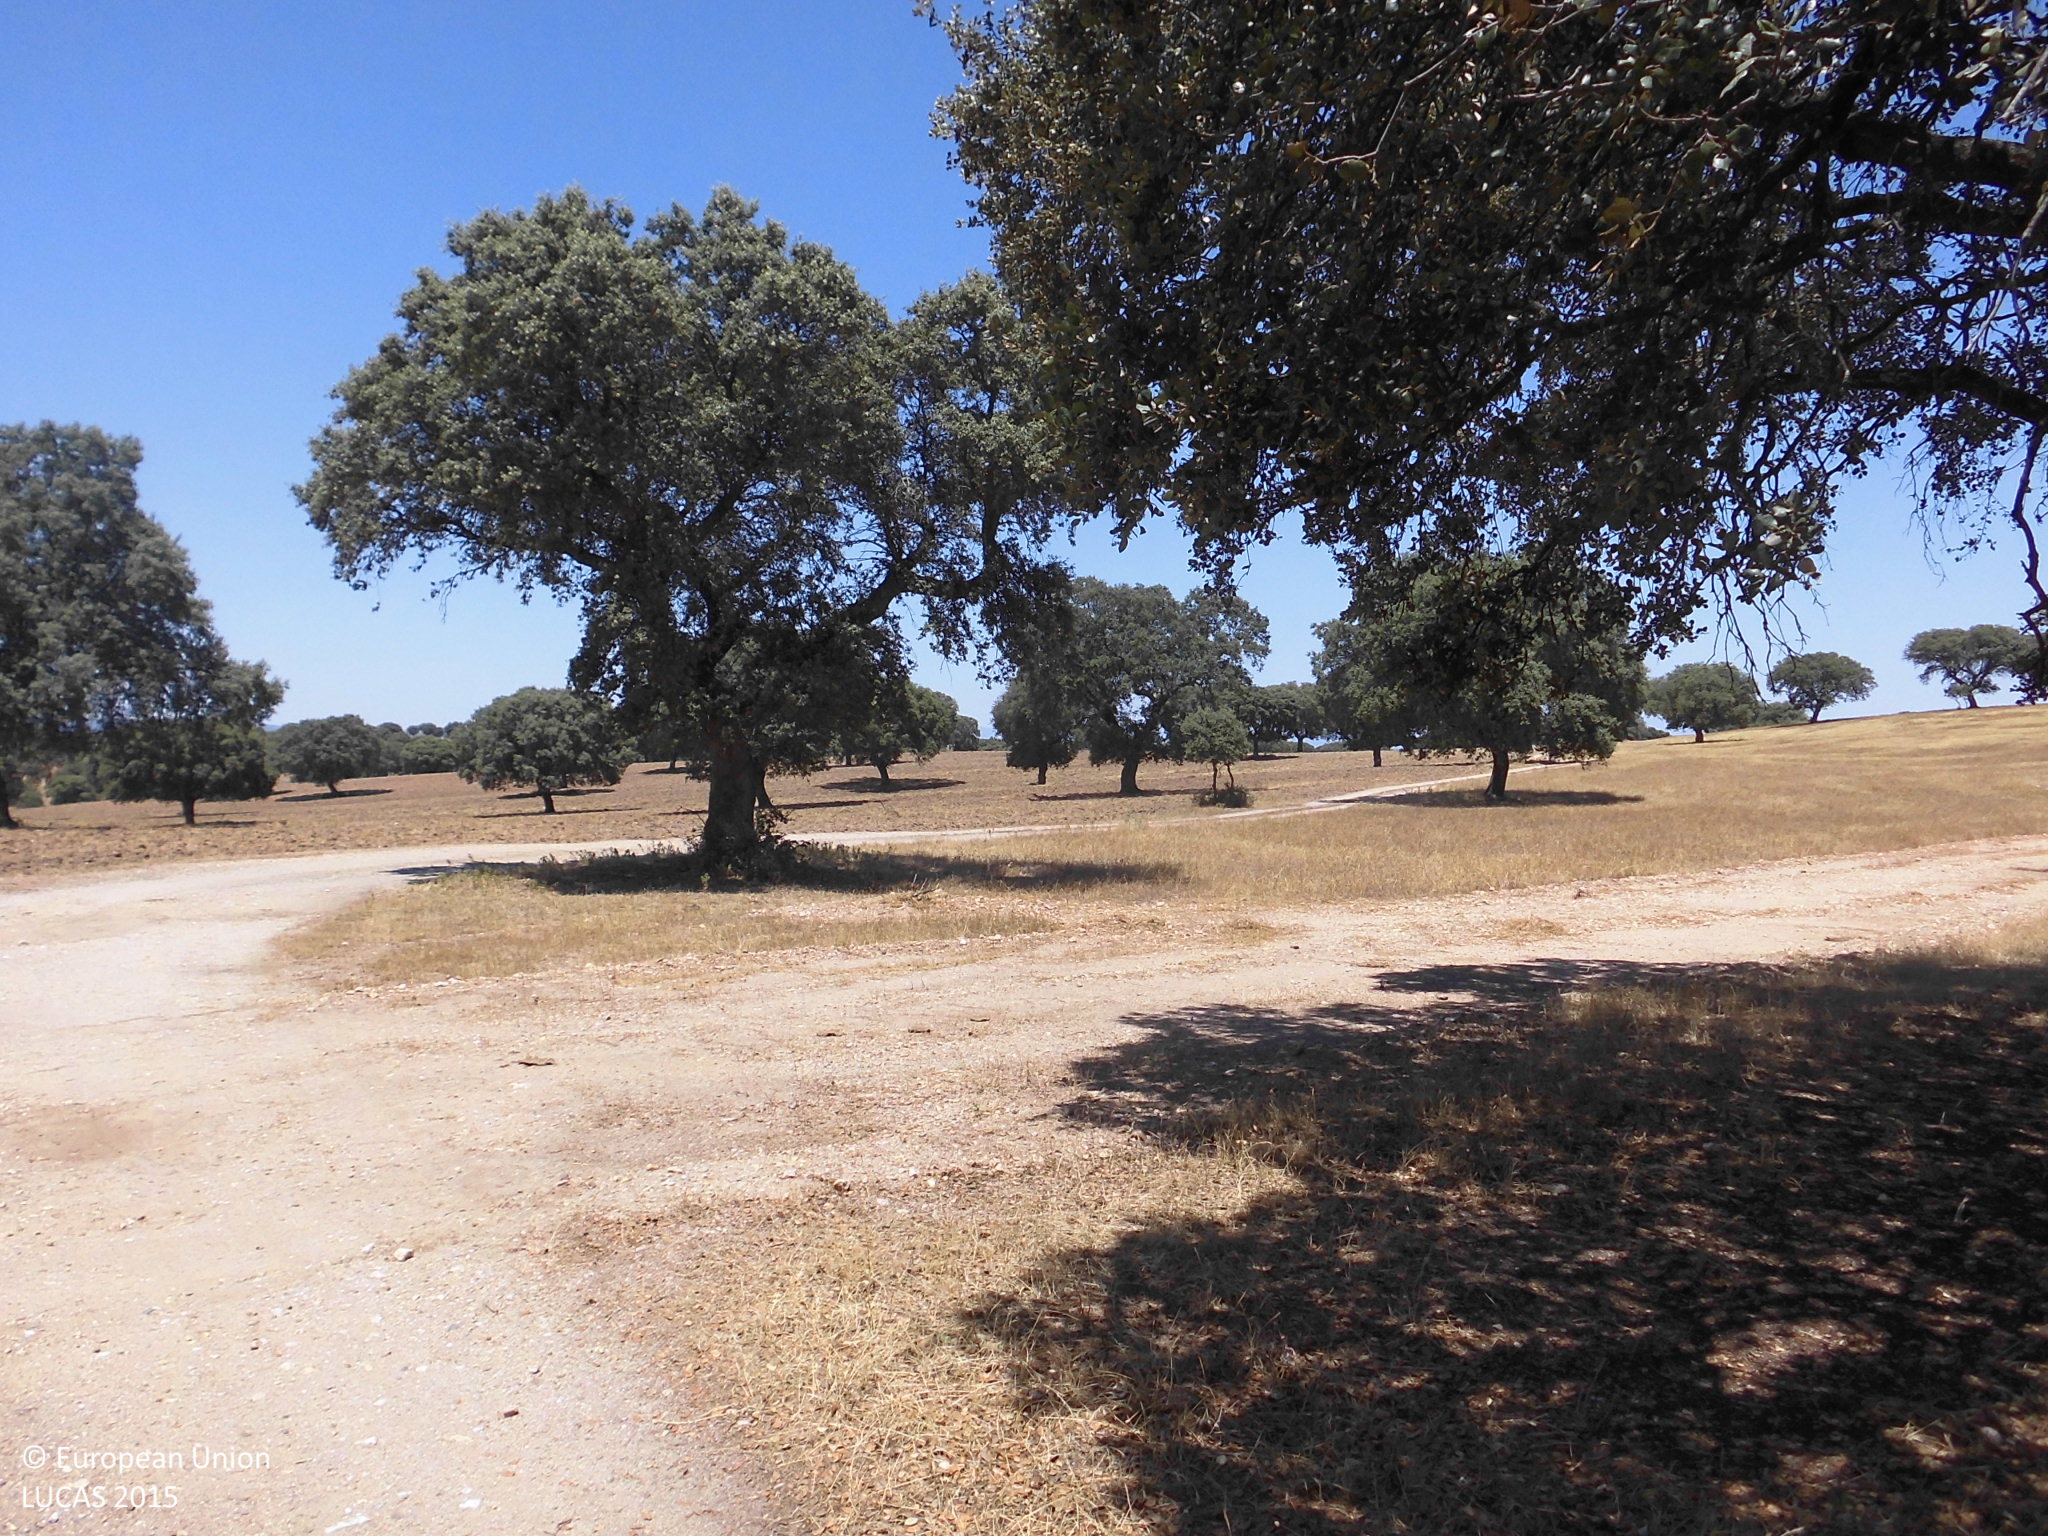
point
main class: Woodland
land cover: Broadleaved woodland
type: broadleaved evergreen forest
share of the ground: 10 - 25 %
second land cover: Grassland without tree/shrub cover
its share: > 75 %
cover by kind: herbaceous plants 90 %, broadleaved forest trees 10 %
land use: Forestry
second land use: Agriculture (excluding fallow land and kitchen gardens)
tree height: > 5 m
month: June
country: ES
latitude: 39.6867
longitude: -6.0750
